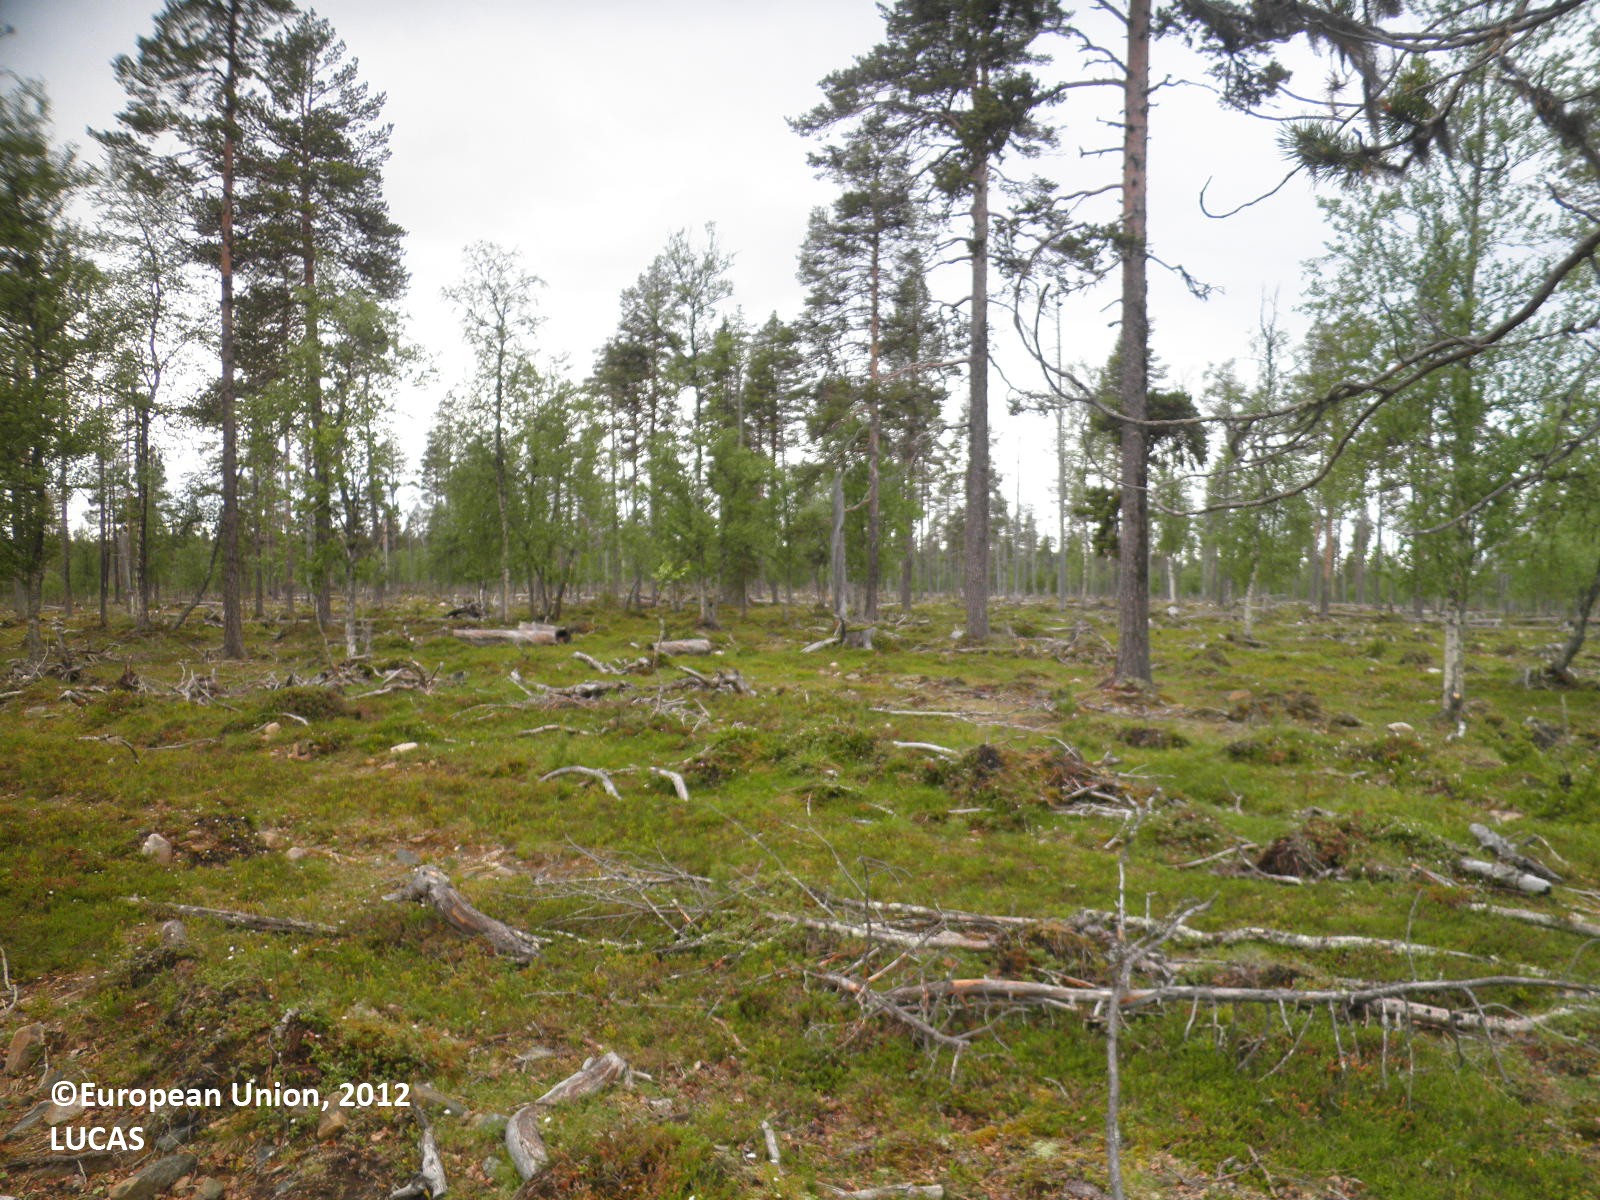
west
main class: Woodland
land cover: Pine dominated mixed woodland
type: boreal forest
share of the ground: 10 - 25 %
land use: Forestry
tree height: > 5 m
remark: Harvested field
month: July
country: FI
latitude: 68.4188
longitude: 25.8524
